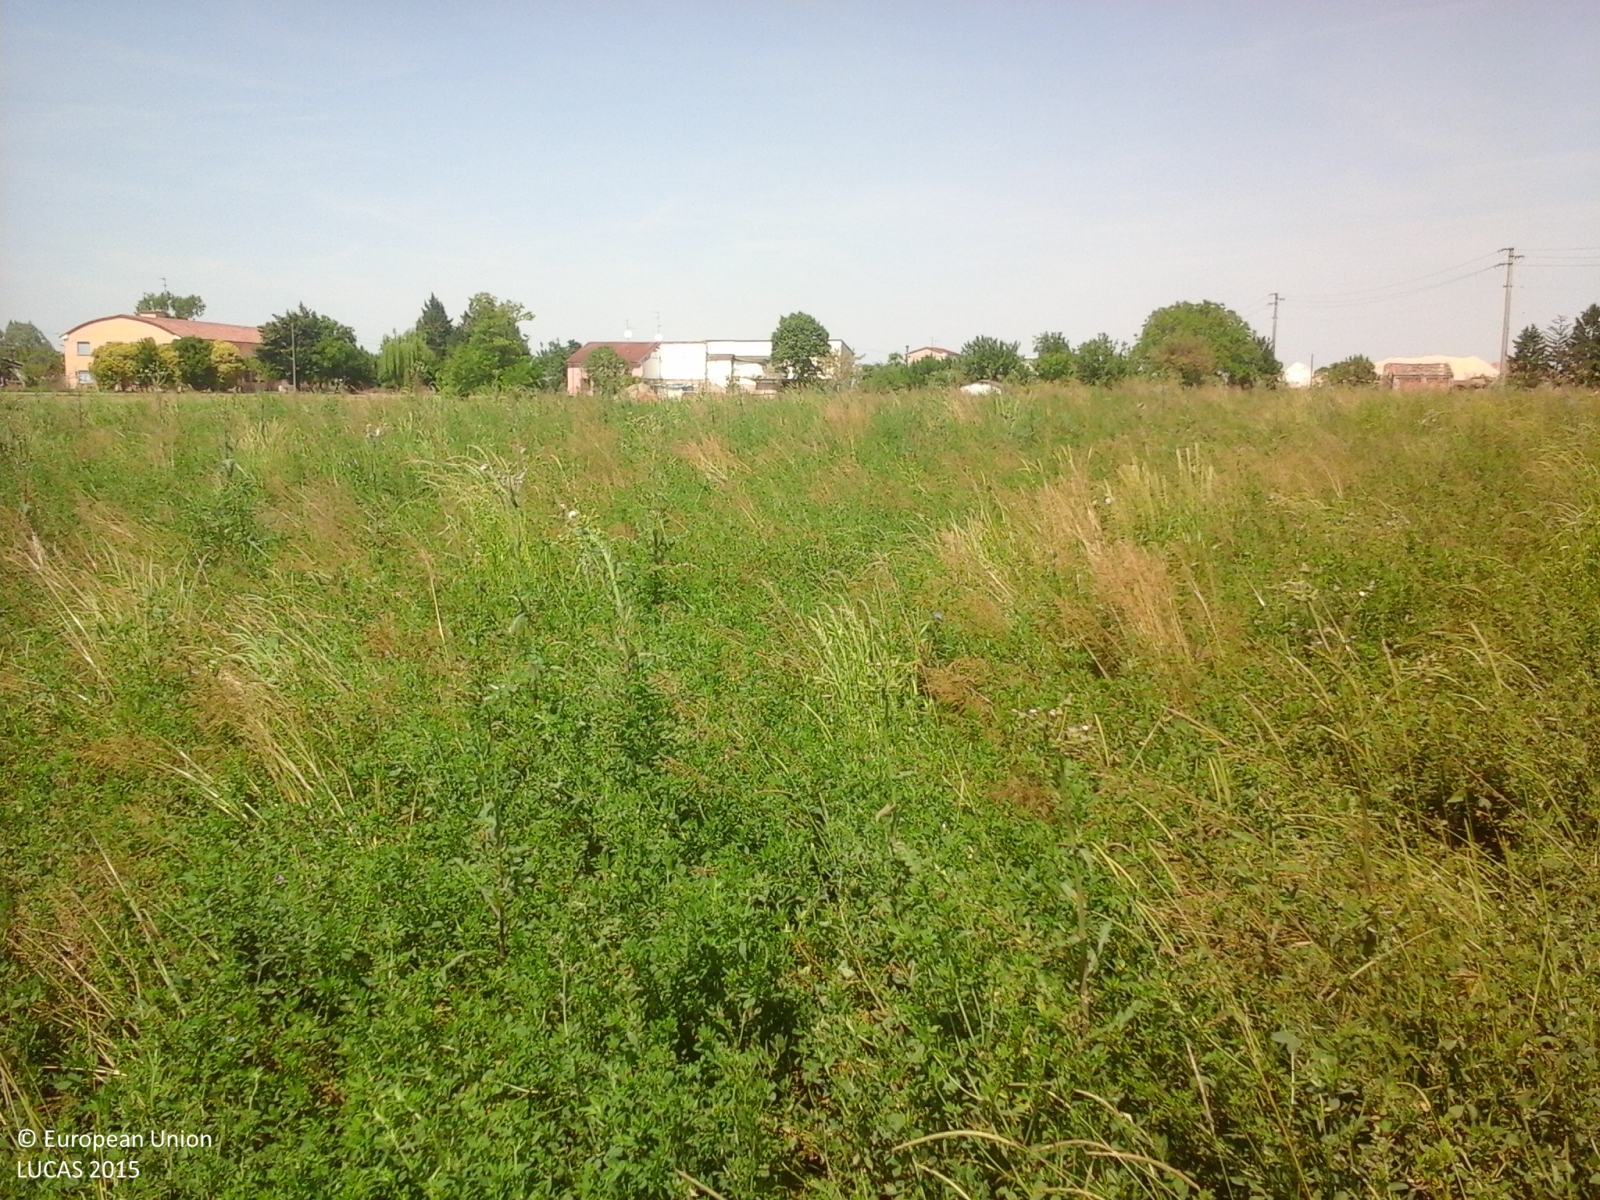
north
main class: Cropland
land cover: Lucerne
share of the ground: > 75 %
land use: Agriculture (excluding fallow land and kitchen gardens)
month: May
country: IT
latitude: 44.9759
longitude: 11.1011
